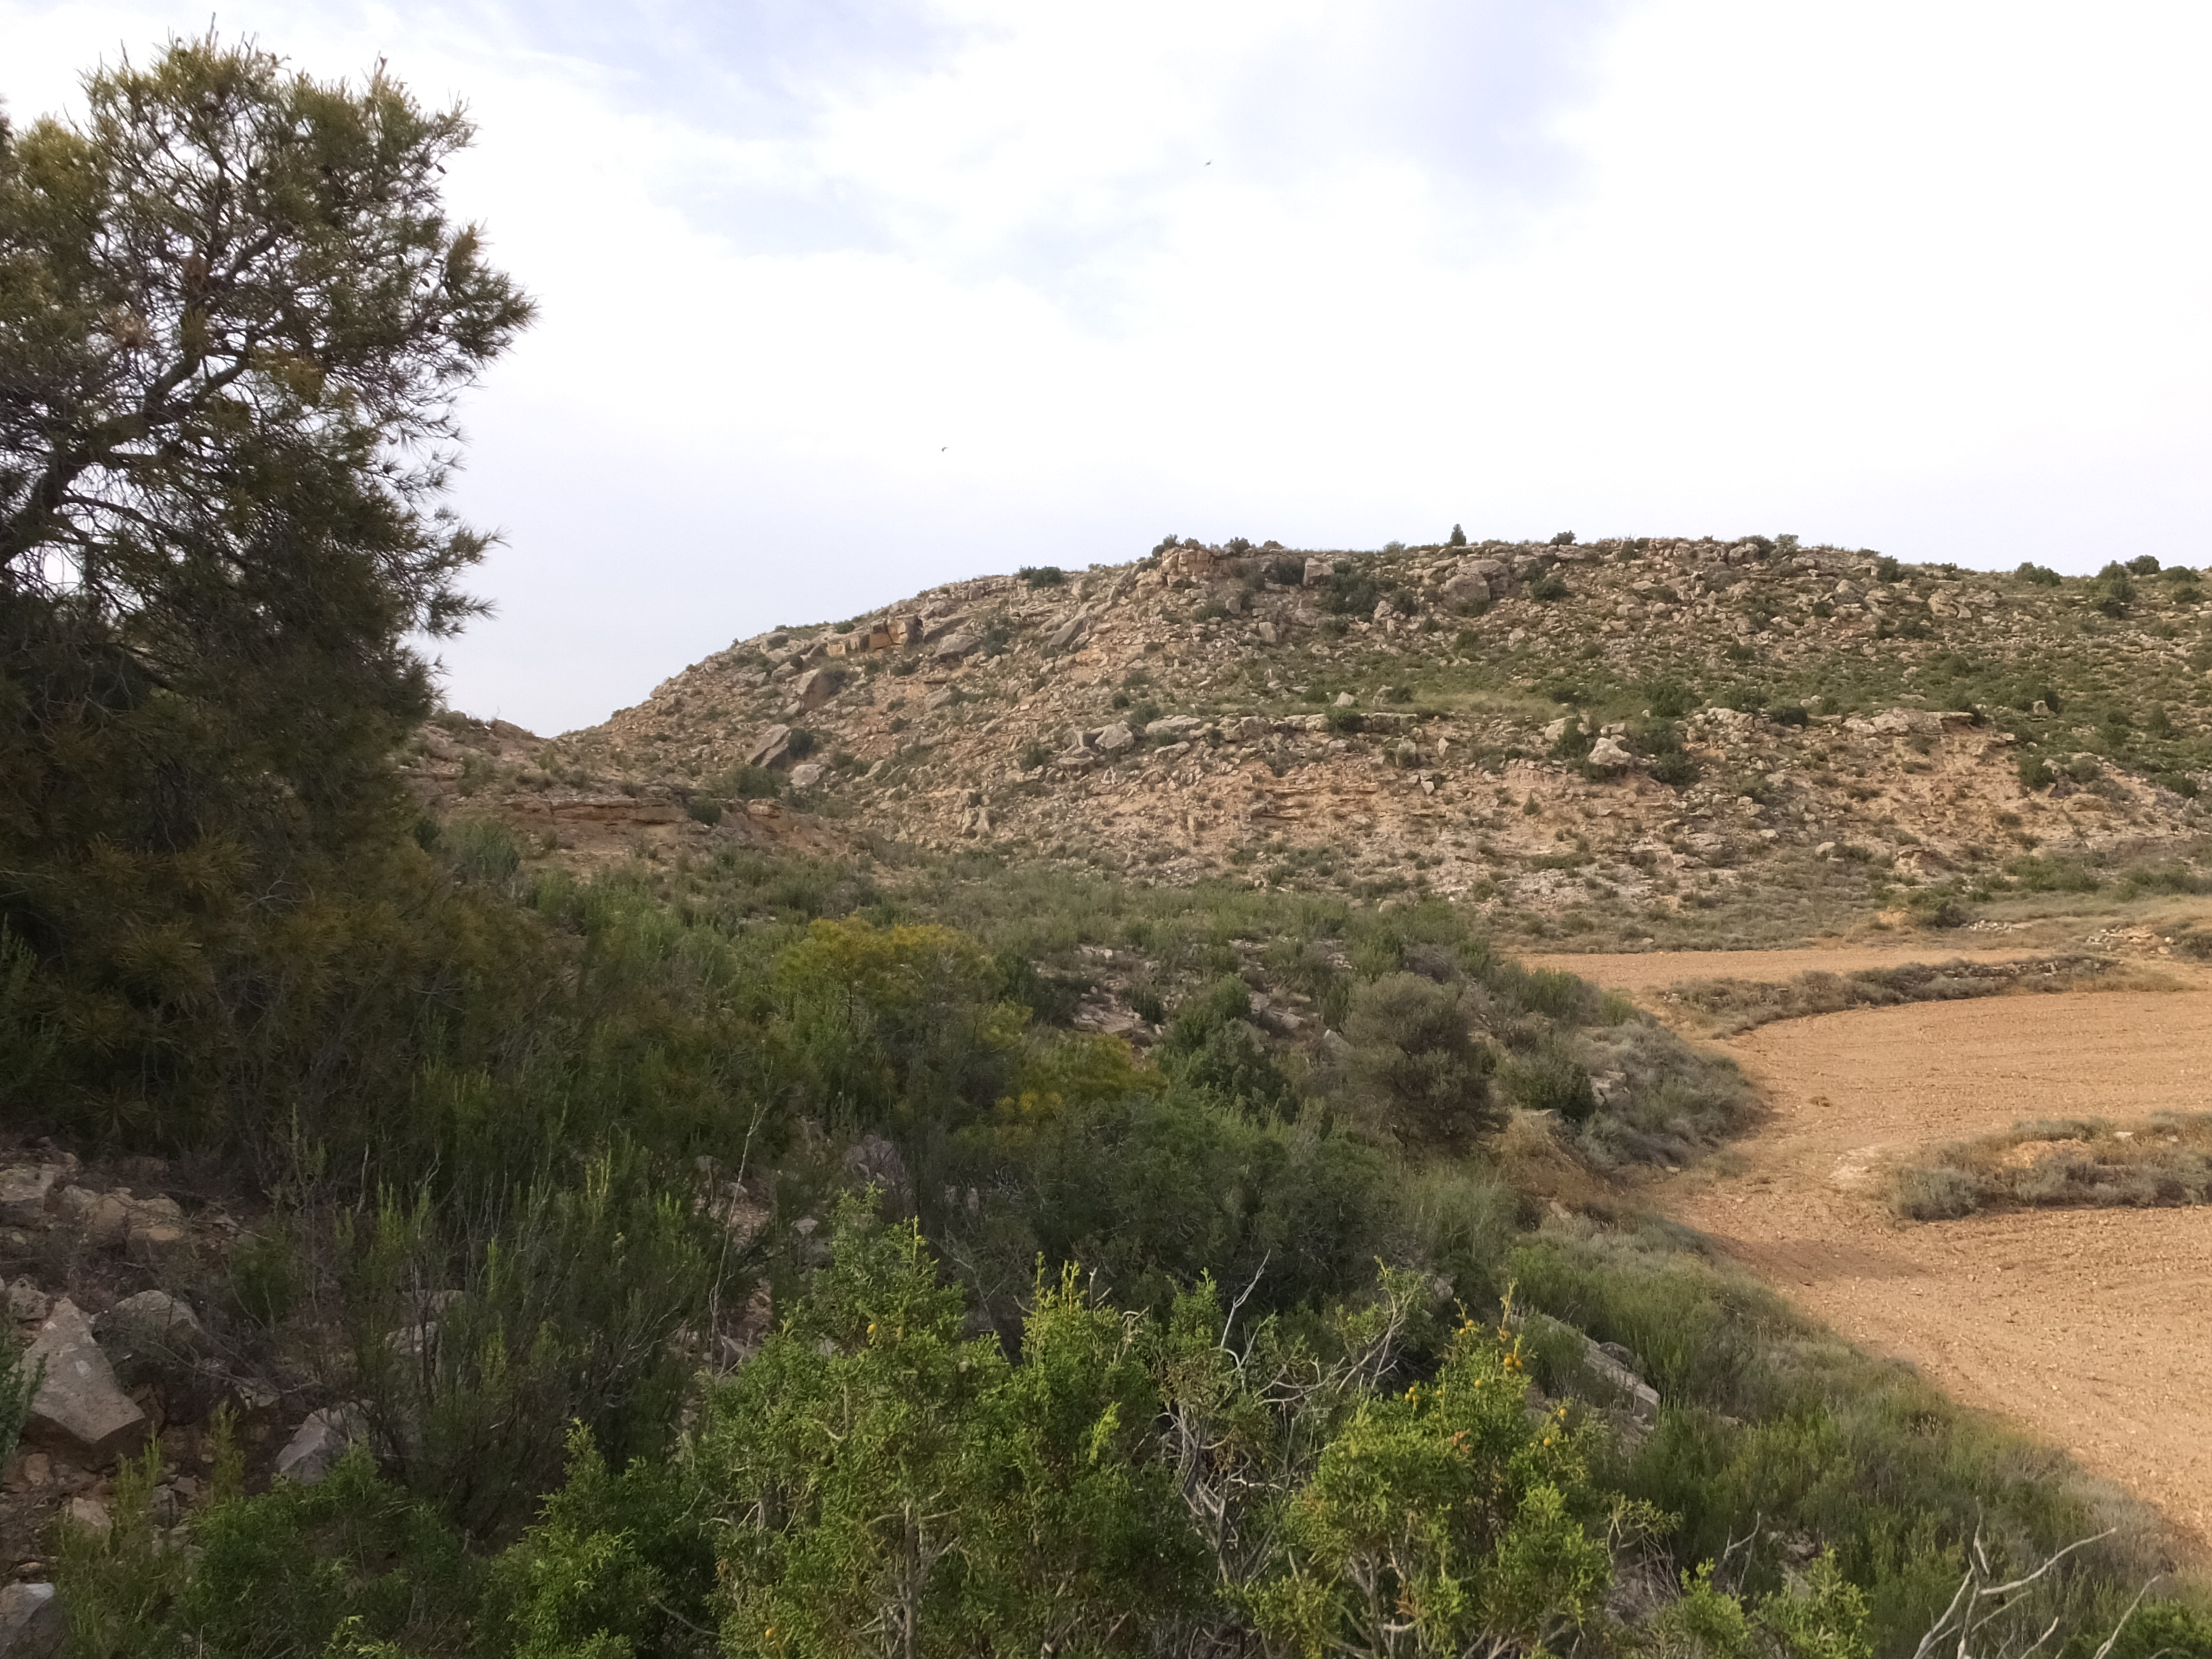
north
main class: Shrubland
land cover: Shrubland with sparse tree cover
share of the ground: > 75 %
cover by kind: shrubs 75 %, herbaceous plants 20 %, coniferous forest trees 5 %
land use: Semi-natural and natural areas not in use
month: May
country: ES
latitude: 41.3136
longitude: -0.2515
